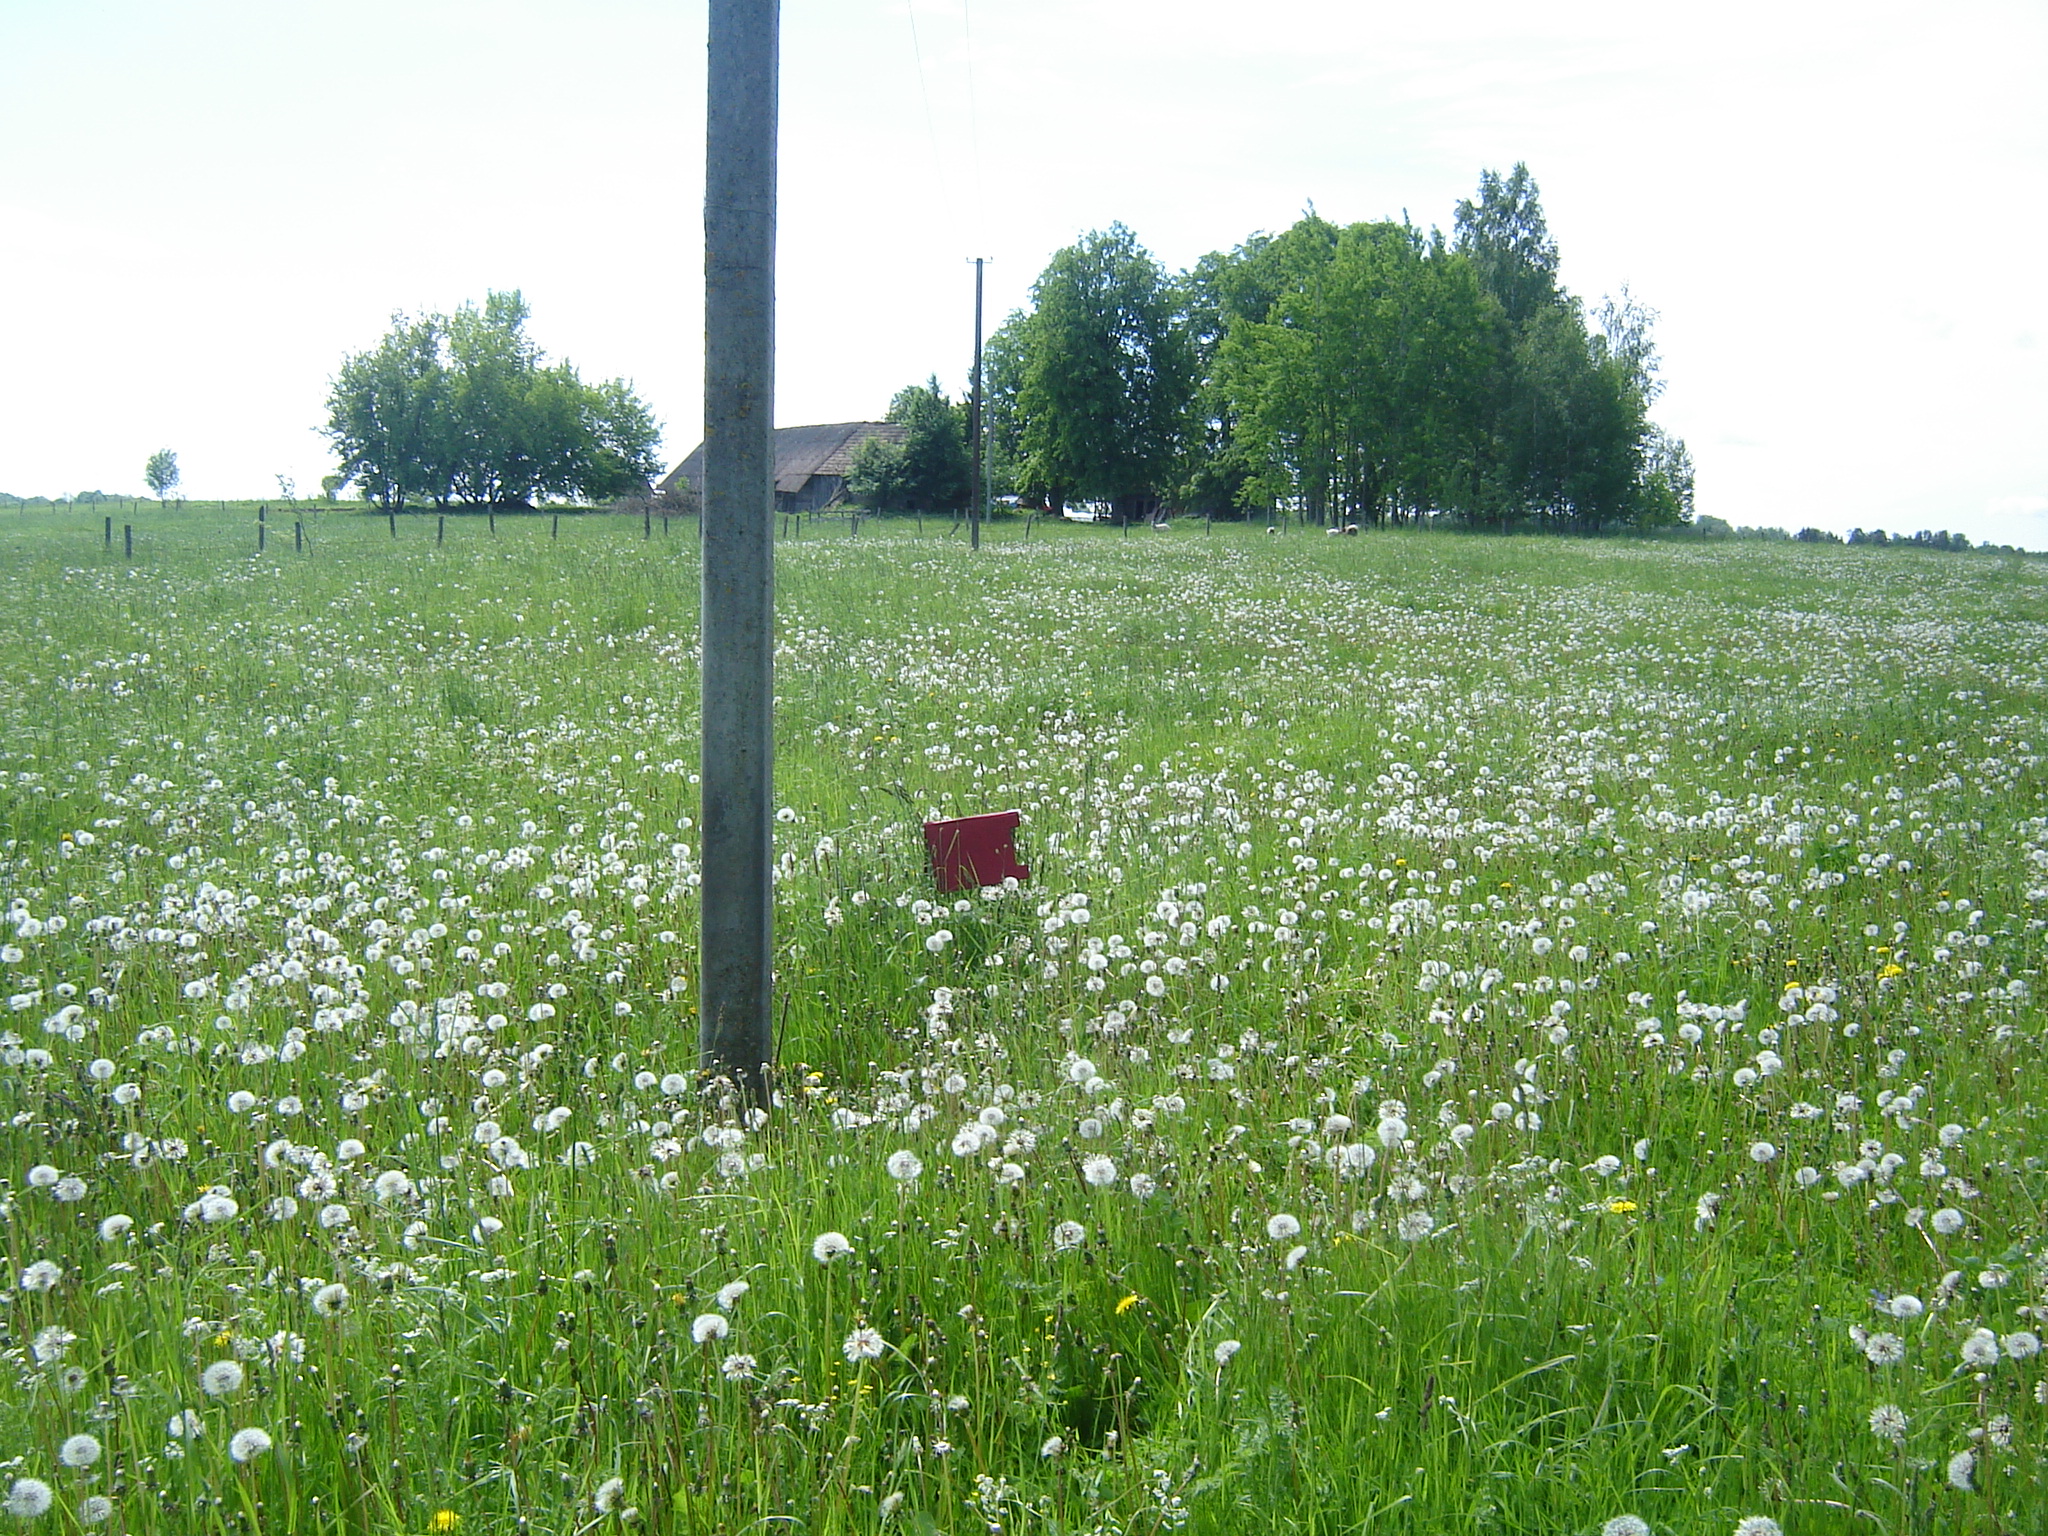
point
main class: Grassland
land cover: Grassland without tree/shrub cover
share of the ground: > 75 %
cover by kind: herbaceous plants 100 %
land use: Agriculture (excluding fallow land and kitchen gardens)
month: May
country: LT
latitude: 55.8321
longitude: 25.1374
